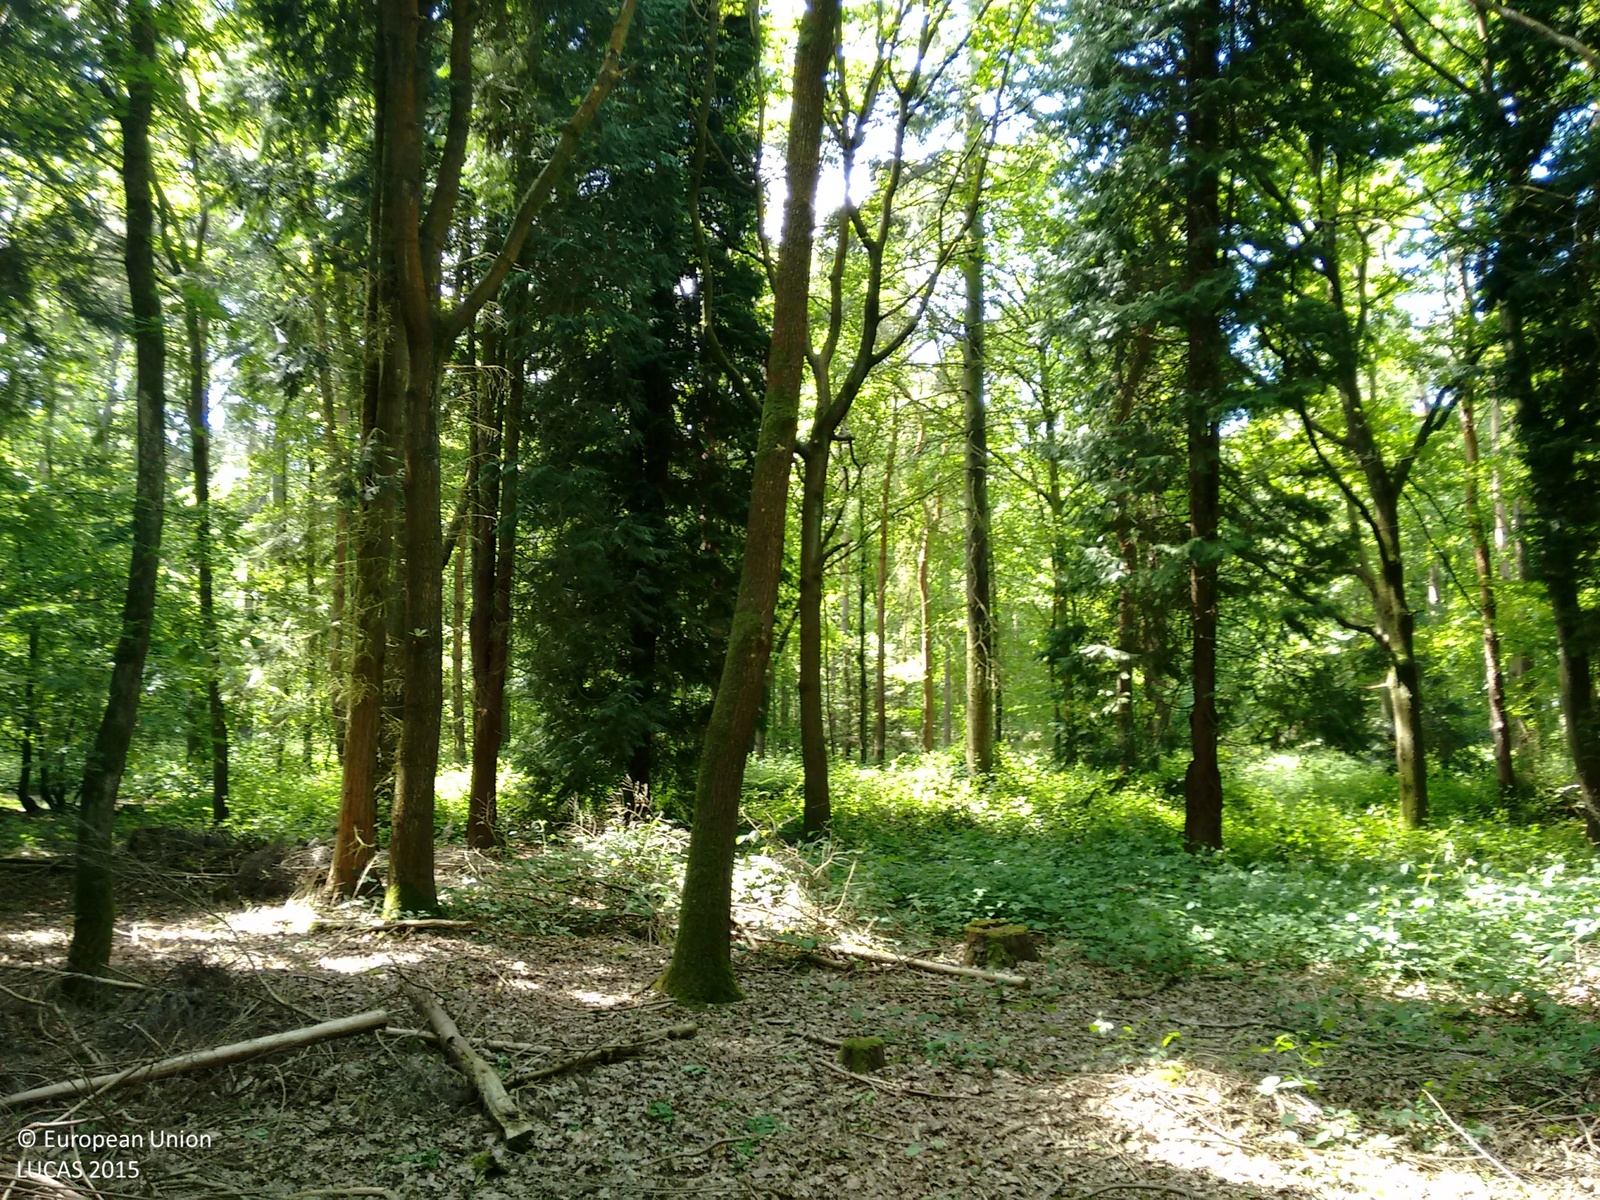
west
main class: Woodland
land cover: Other mixed woodland
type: exotic forest
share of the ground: > 75 %
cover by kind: broadleaved forest trees 50 %, coniferous forest trees 40 %, herbaceous plants 10 %
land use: Forestry
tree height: > 5 m
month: June
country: GB
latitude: 51.8379
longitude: -0.2969
